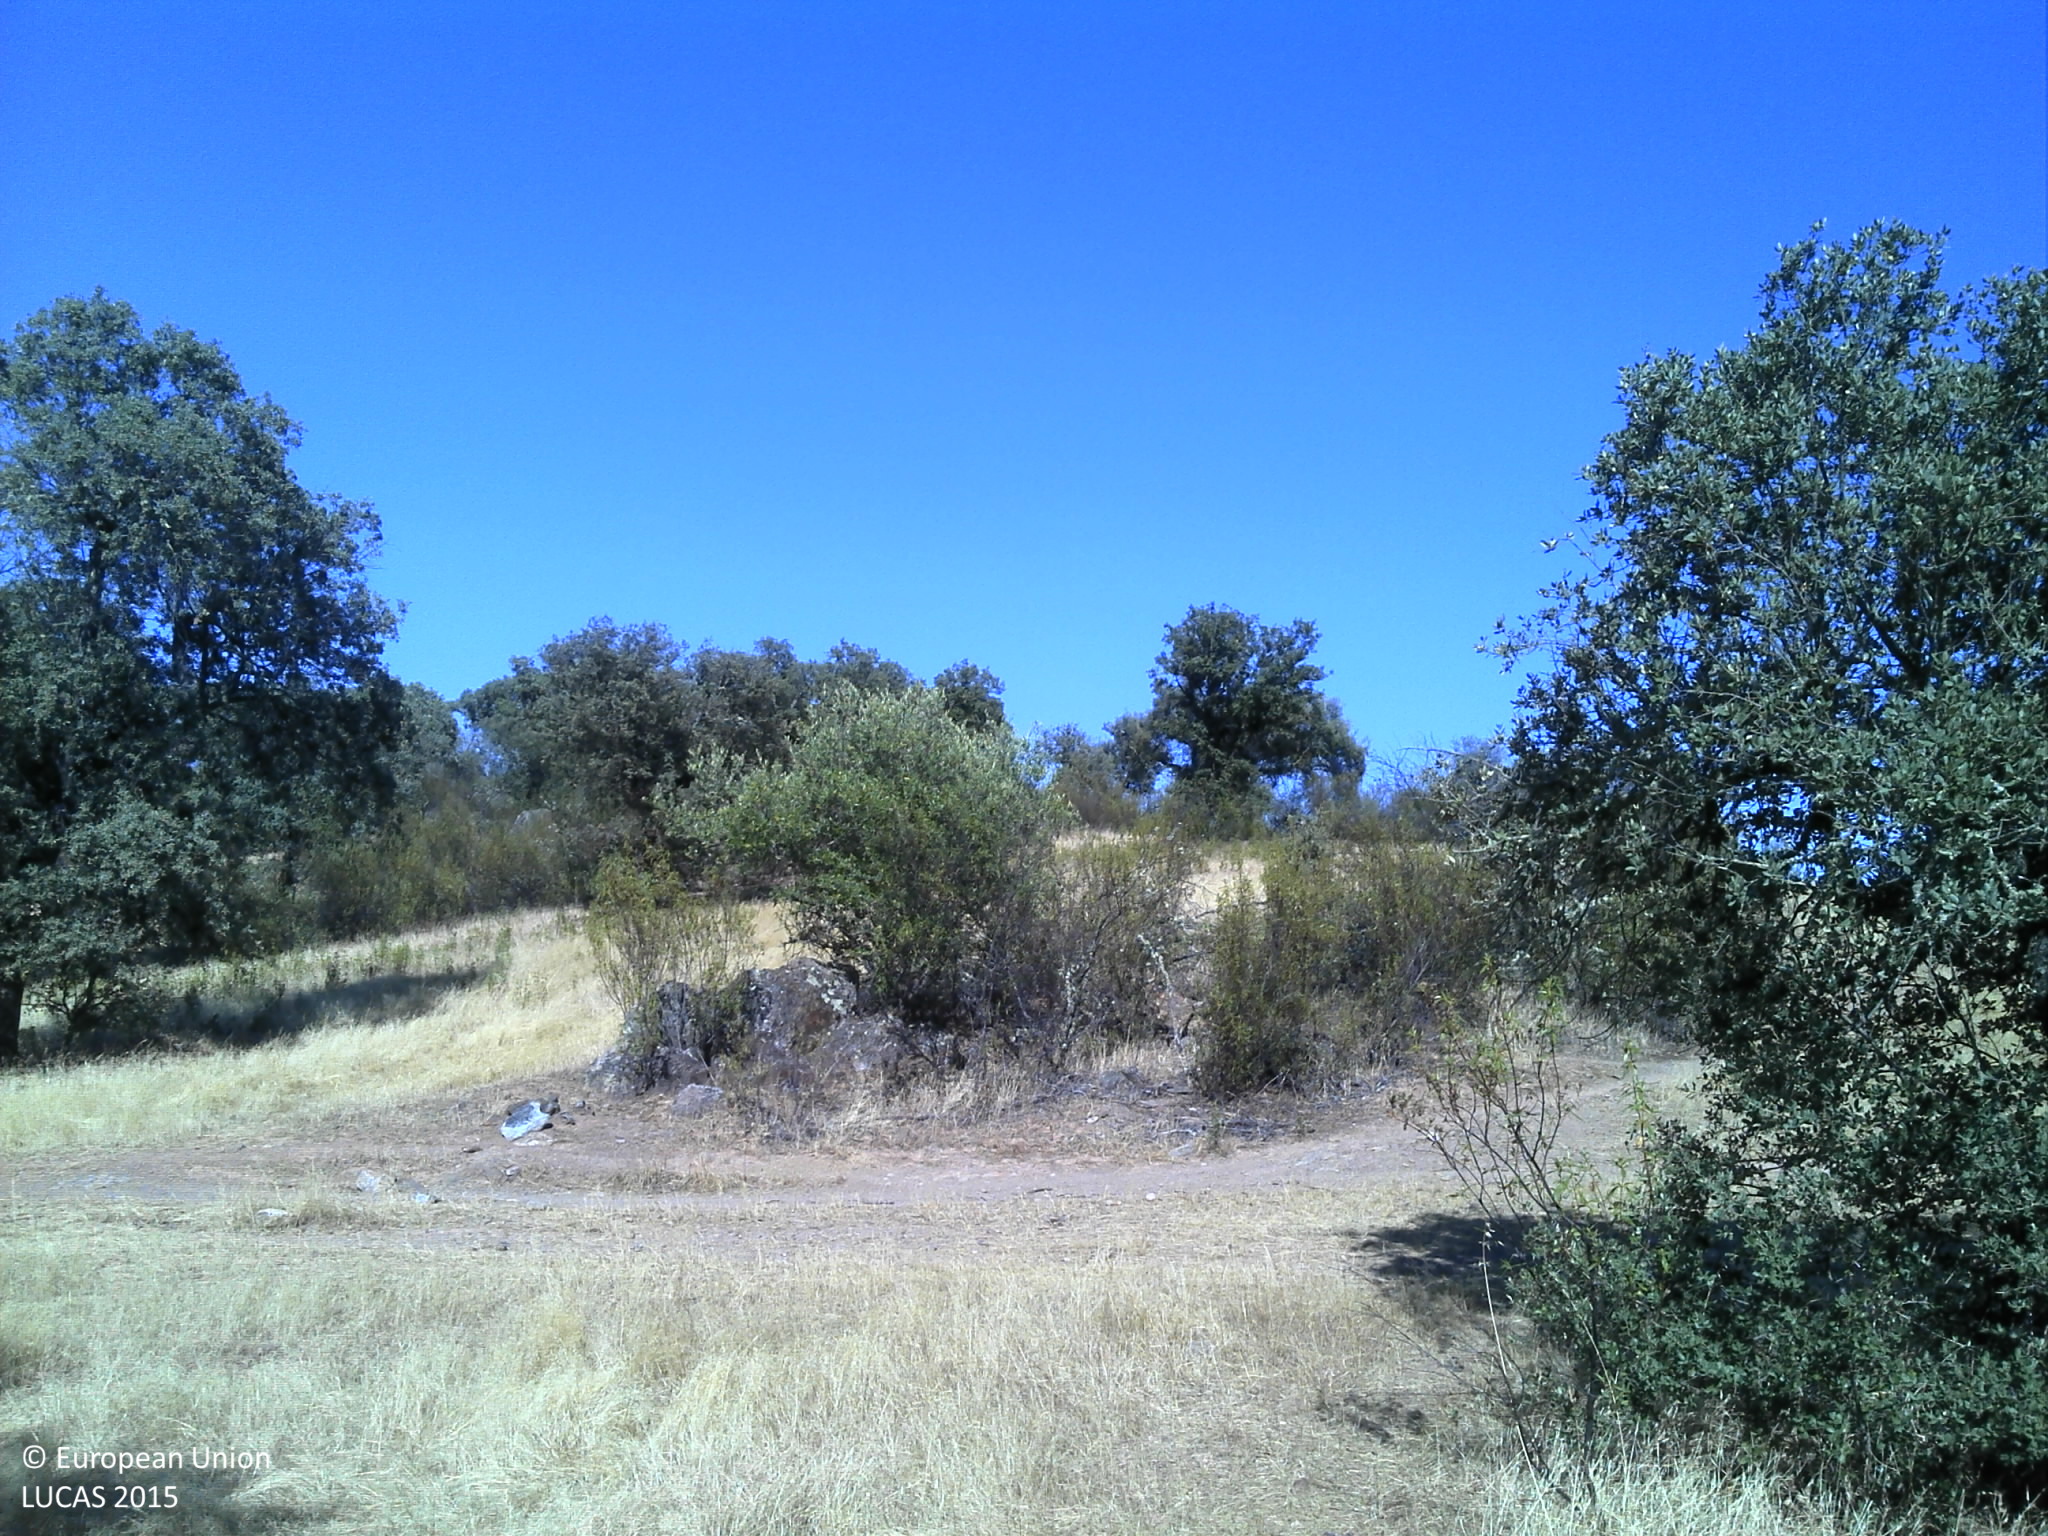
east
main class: Woodland
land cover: Broadleaved woodland
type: broadleaved evergreen forest
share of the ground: 10 - 25 %
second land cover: Grassland without tree/shrub cover
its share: 50 - 75 %
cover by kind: herbaceous plants 60 %, unconsolidated bare surface 25 %, broadleaved forest trees 10 %, shrubs 5 %
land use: Forestry
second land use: Agriculture (excluding fallow land and kitchen gardens)
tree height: > 5 m
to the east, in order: Broadleaved woodland; Grassland without tree/shrub cover; Broadleaved woodland; Shrubland without tree cover; Broadleaved woodland; Grassland without tree/shrub cover; Broadleaved woodland; Grassland without tree/shrub cover; Broadleaved woodland; Grassland without tree/shrub cover; Broadleaved woodland
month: July
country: PT
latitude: 38.5833
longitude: -7.3260
